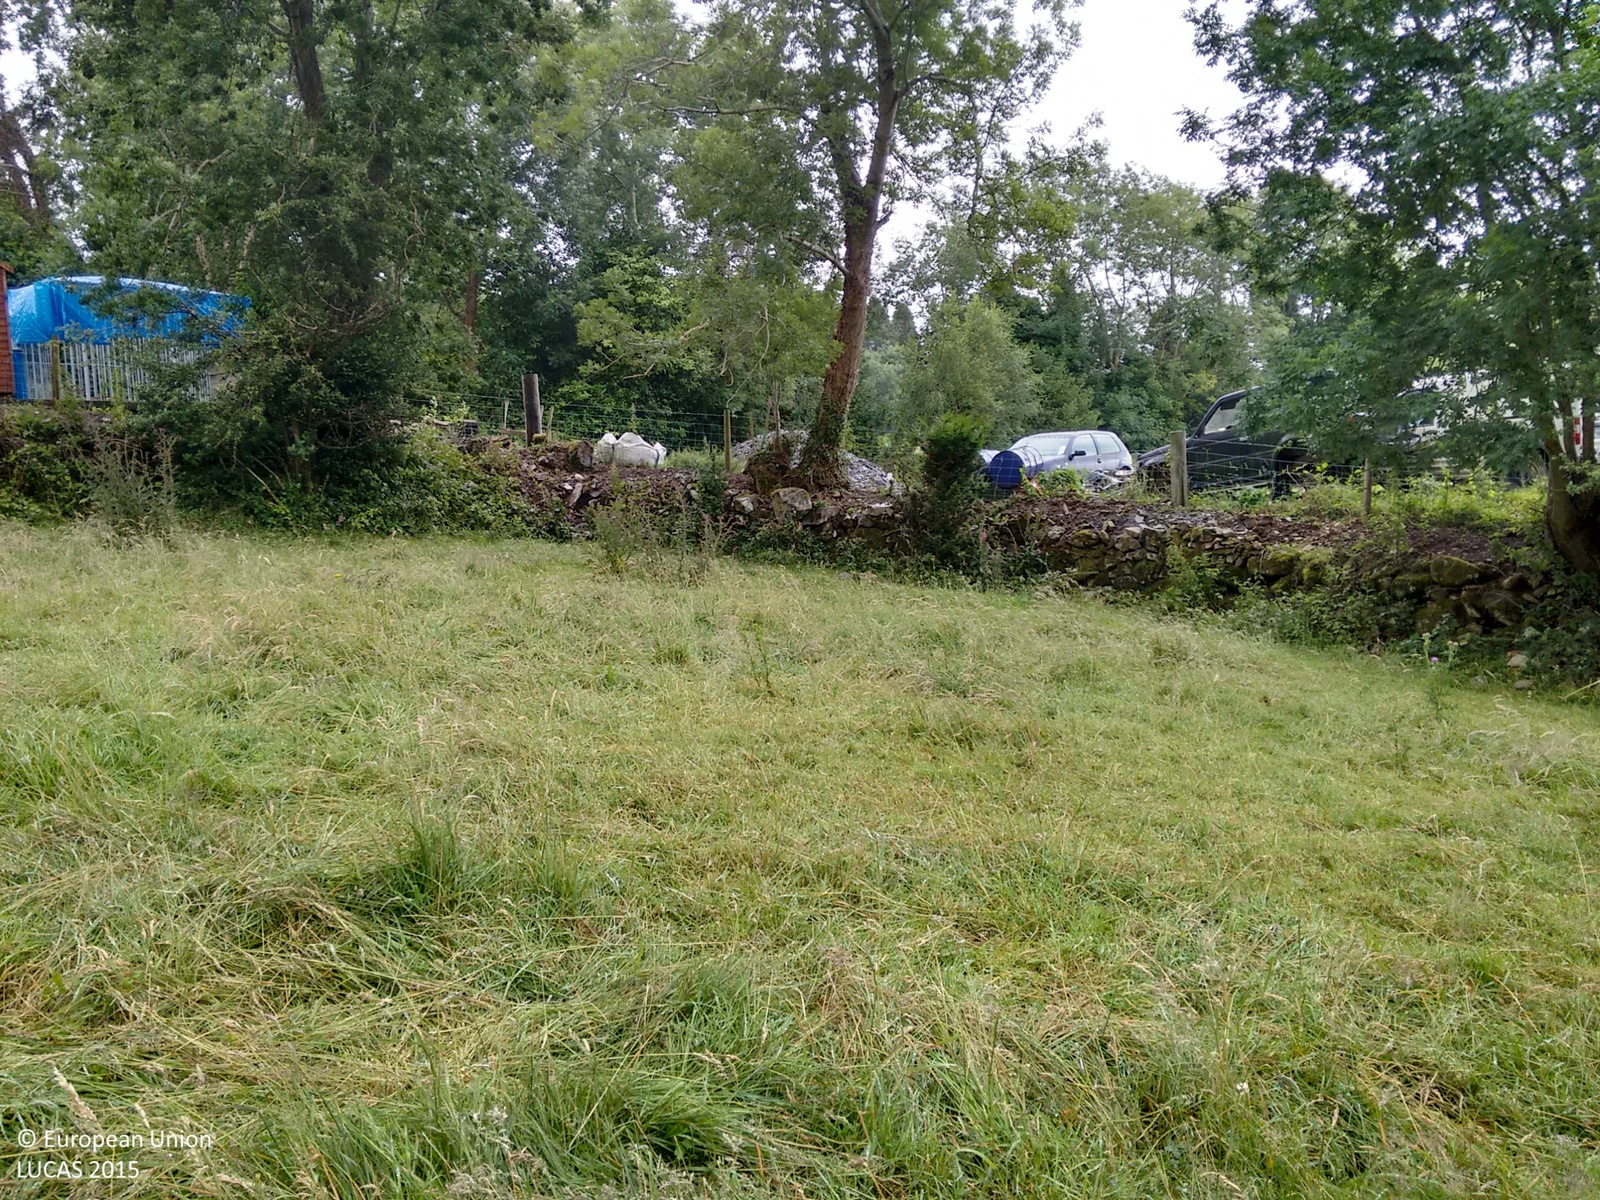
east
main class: Grassland
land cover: Grassland without tree/shrub cover
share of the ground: > 75 %
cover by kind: herbaceous plants 100 %
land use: Agriculture (excluding fallow land and kitchen gardens)
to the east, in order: Grassland without tree/shrub cover; Broadleaved woodland; Grassland without tree/shrub cover; Broadleaved woodland; Grassland without tree/shrub cover; Tracks; Managed hedges; Grassland without tree/shrub cover
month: July
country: IE
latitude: 52.9305
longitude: -6.2923
